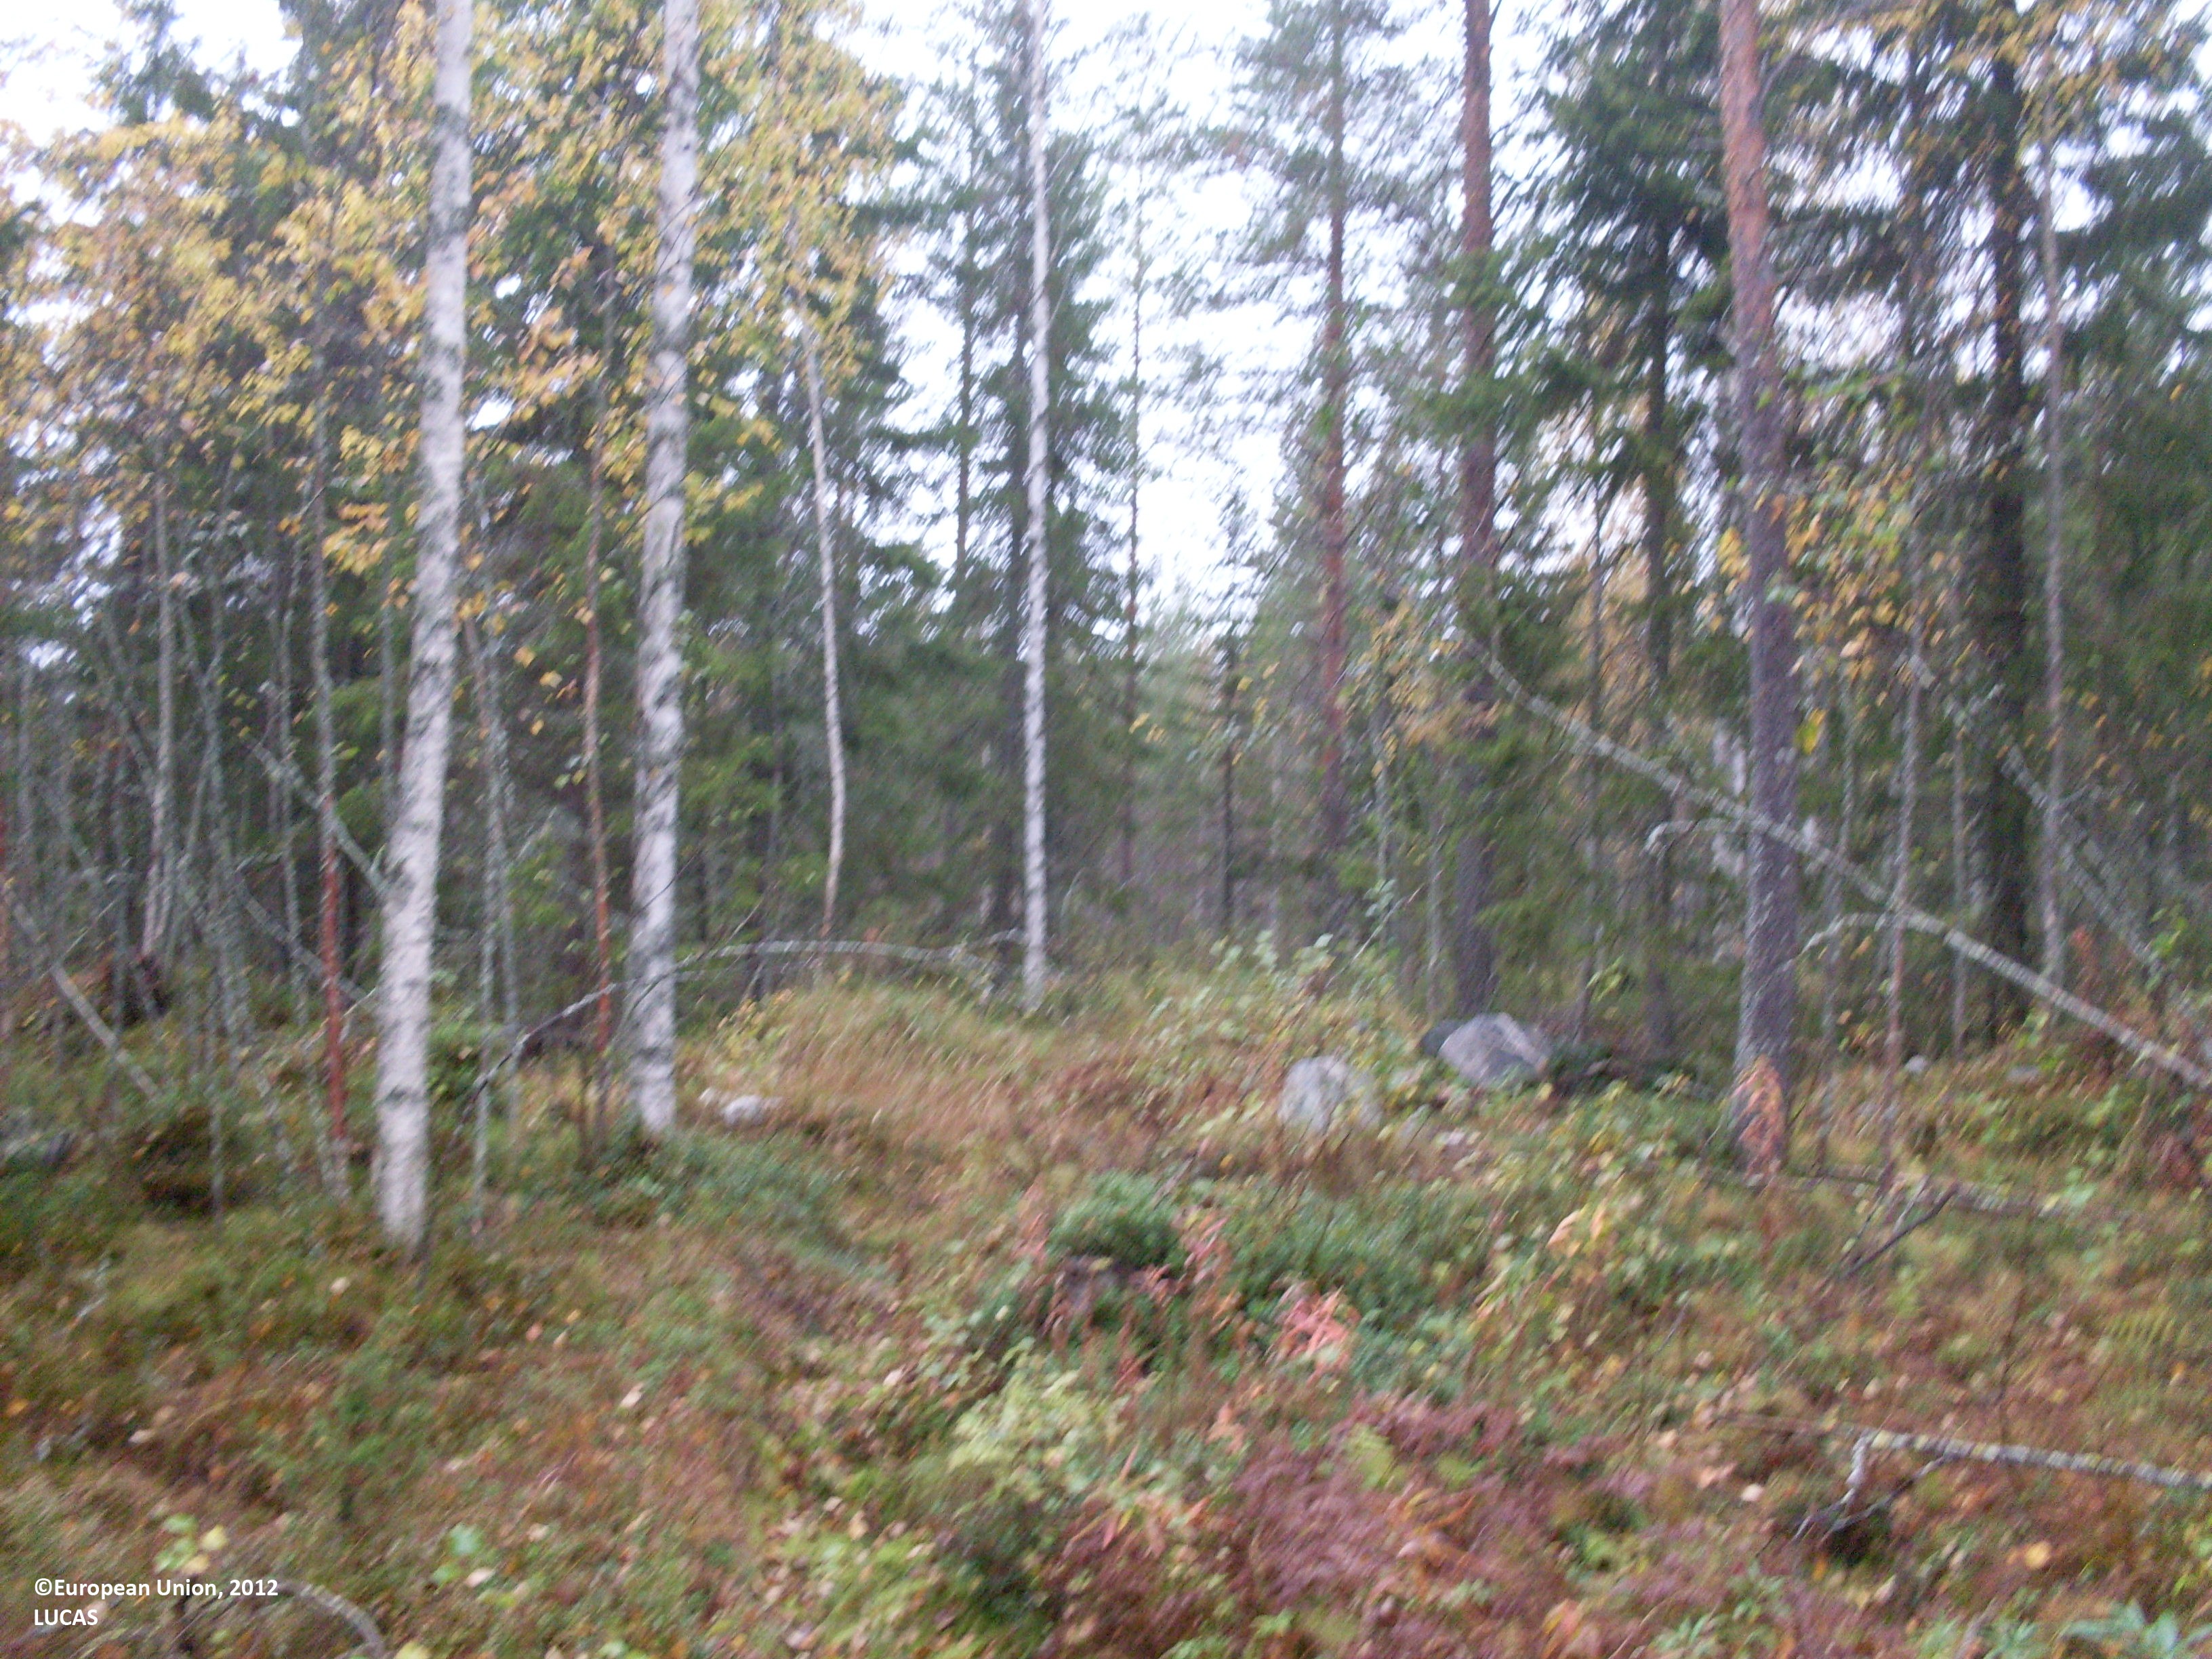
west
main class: Woodland
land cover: Spruce dominated mixed woodland
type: boreal forest
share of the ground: 50 - 75 %
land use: Forestry
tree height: > 5 m
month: September
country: FI
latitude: 64.3080
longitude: 29.3757
